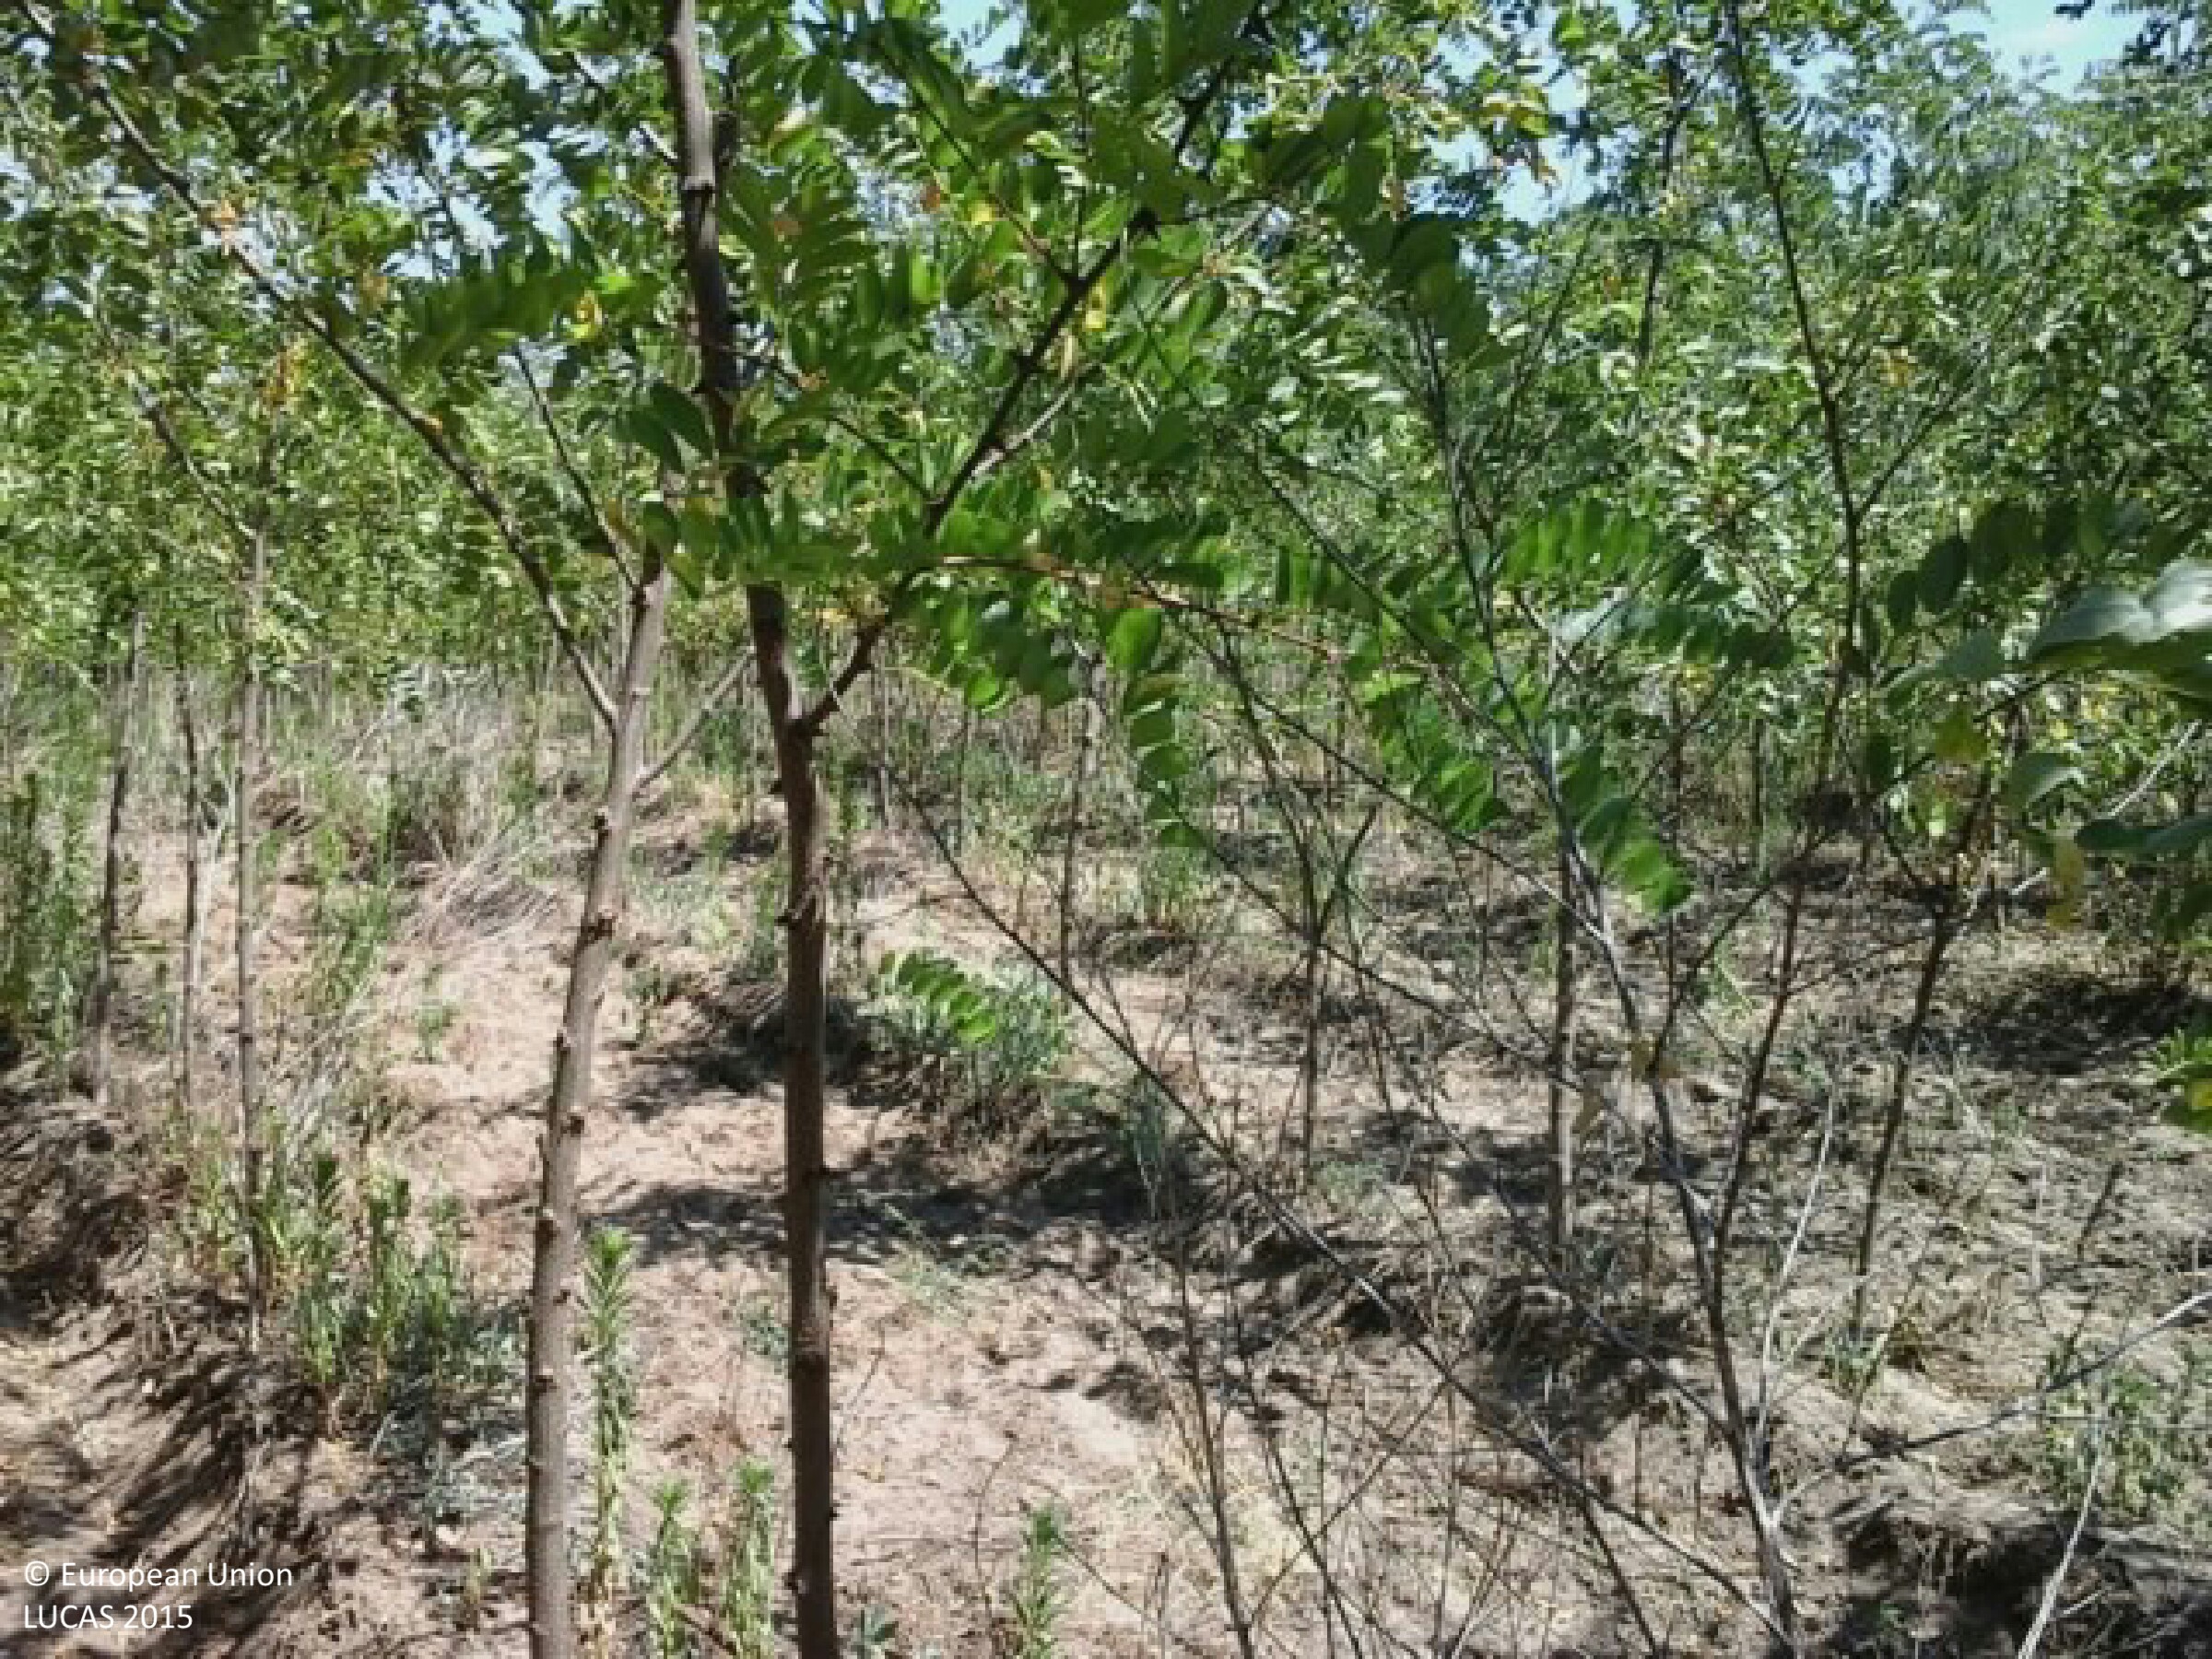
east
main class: Woodland
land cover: Broadleaved woodland
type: exotic forest
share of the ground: 50 - 75 %
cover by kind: broadleaved forest trees 70 %, herbaceous plants 15 %, unconsolidated bare surface 15 %
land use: Forestry
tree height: < 5 m
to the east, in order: Broadleaved woodland; Spontaneously vegetated surfaces; Tracks; Lucerne; Barley; Lucerne; Potatoes
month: July
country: HU
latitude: 47.2896
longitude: 19.2613
